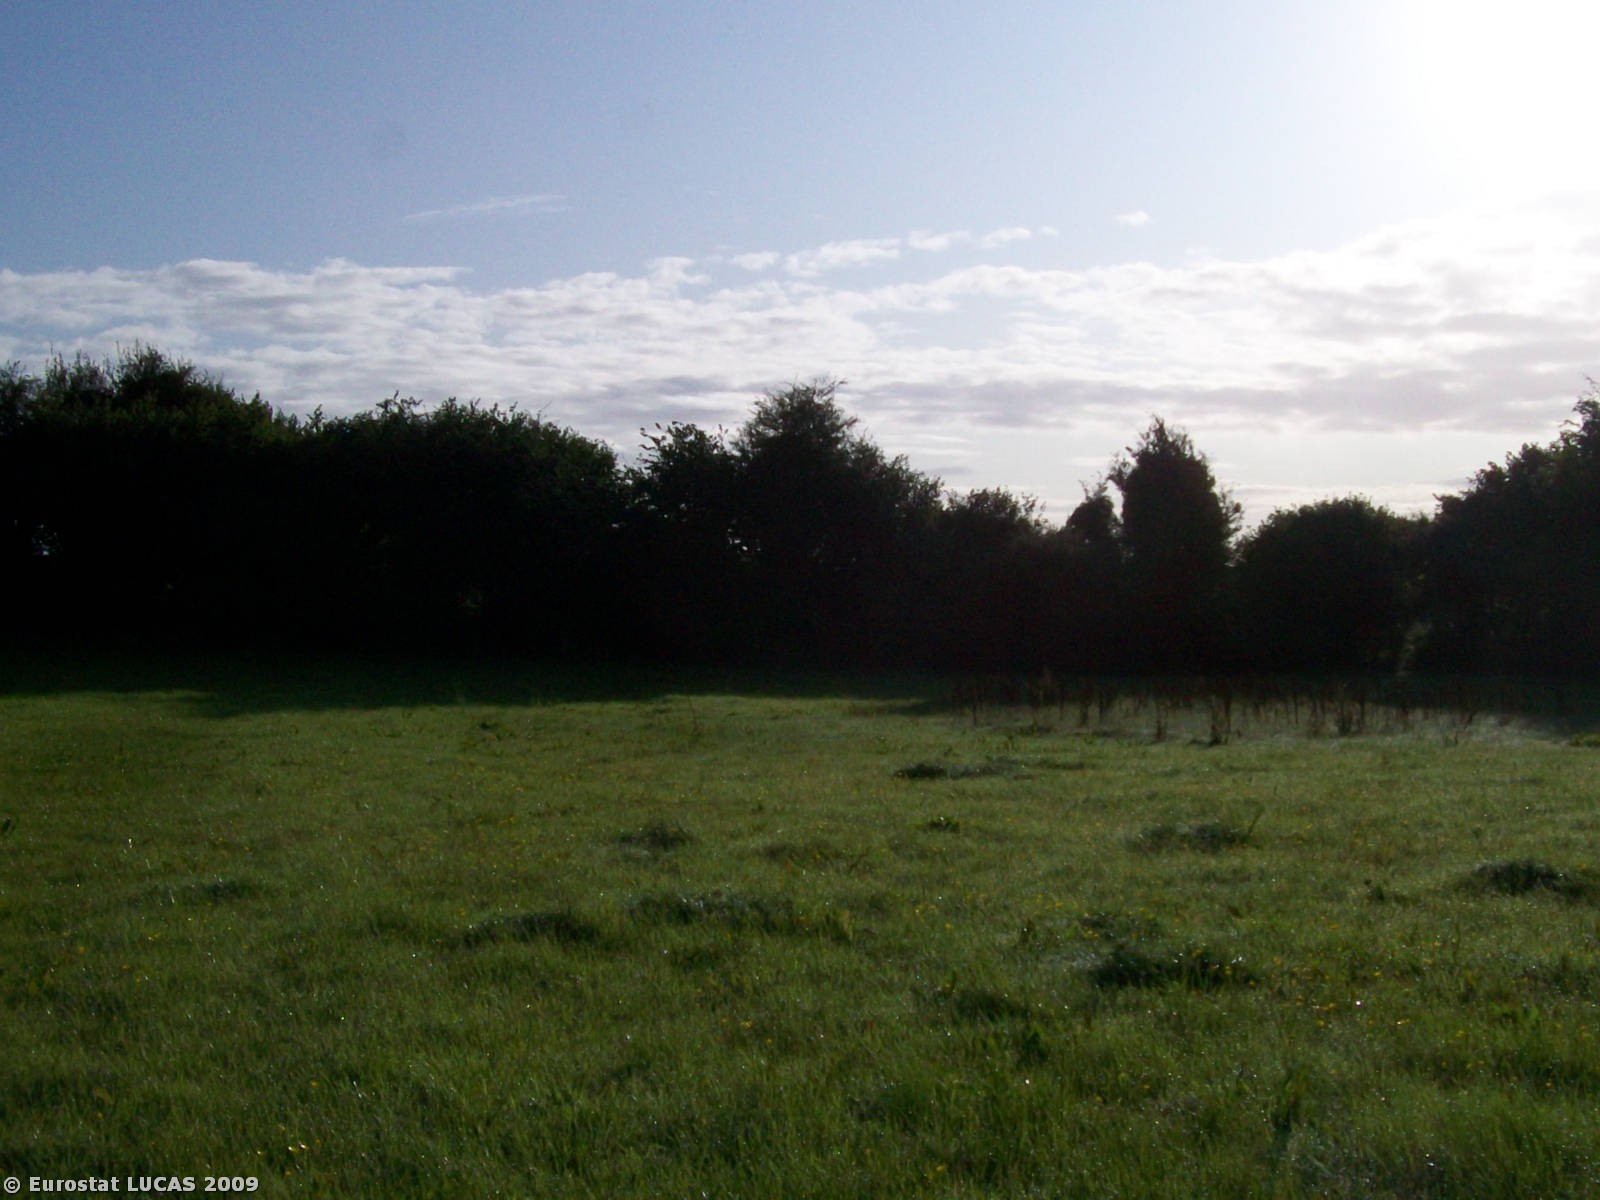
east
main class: Grassland
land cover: Grassland without tree/shrub cover
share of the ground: > 75 %
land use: Agriculture (excluding fallow land and kitchen gardens)
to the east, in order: Grassland without tree/shrub cover; Managed hedges; Dry stone walls; Grassland without tree/shrub cover; Dry stone walls; Managed hedges; Grassland without tree/shrub cover; Managed hedges; Grassland without tree/shrub cover
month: August
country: IE
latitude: 53.2283
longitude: -8.7635
